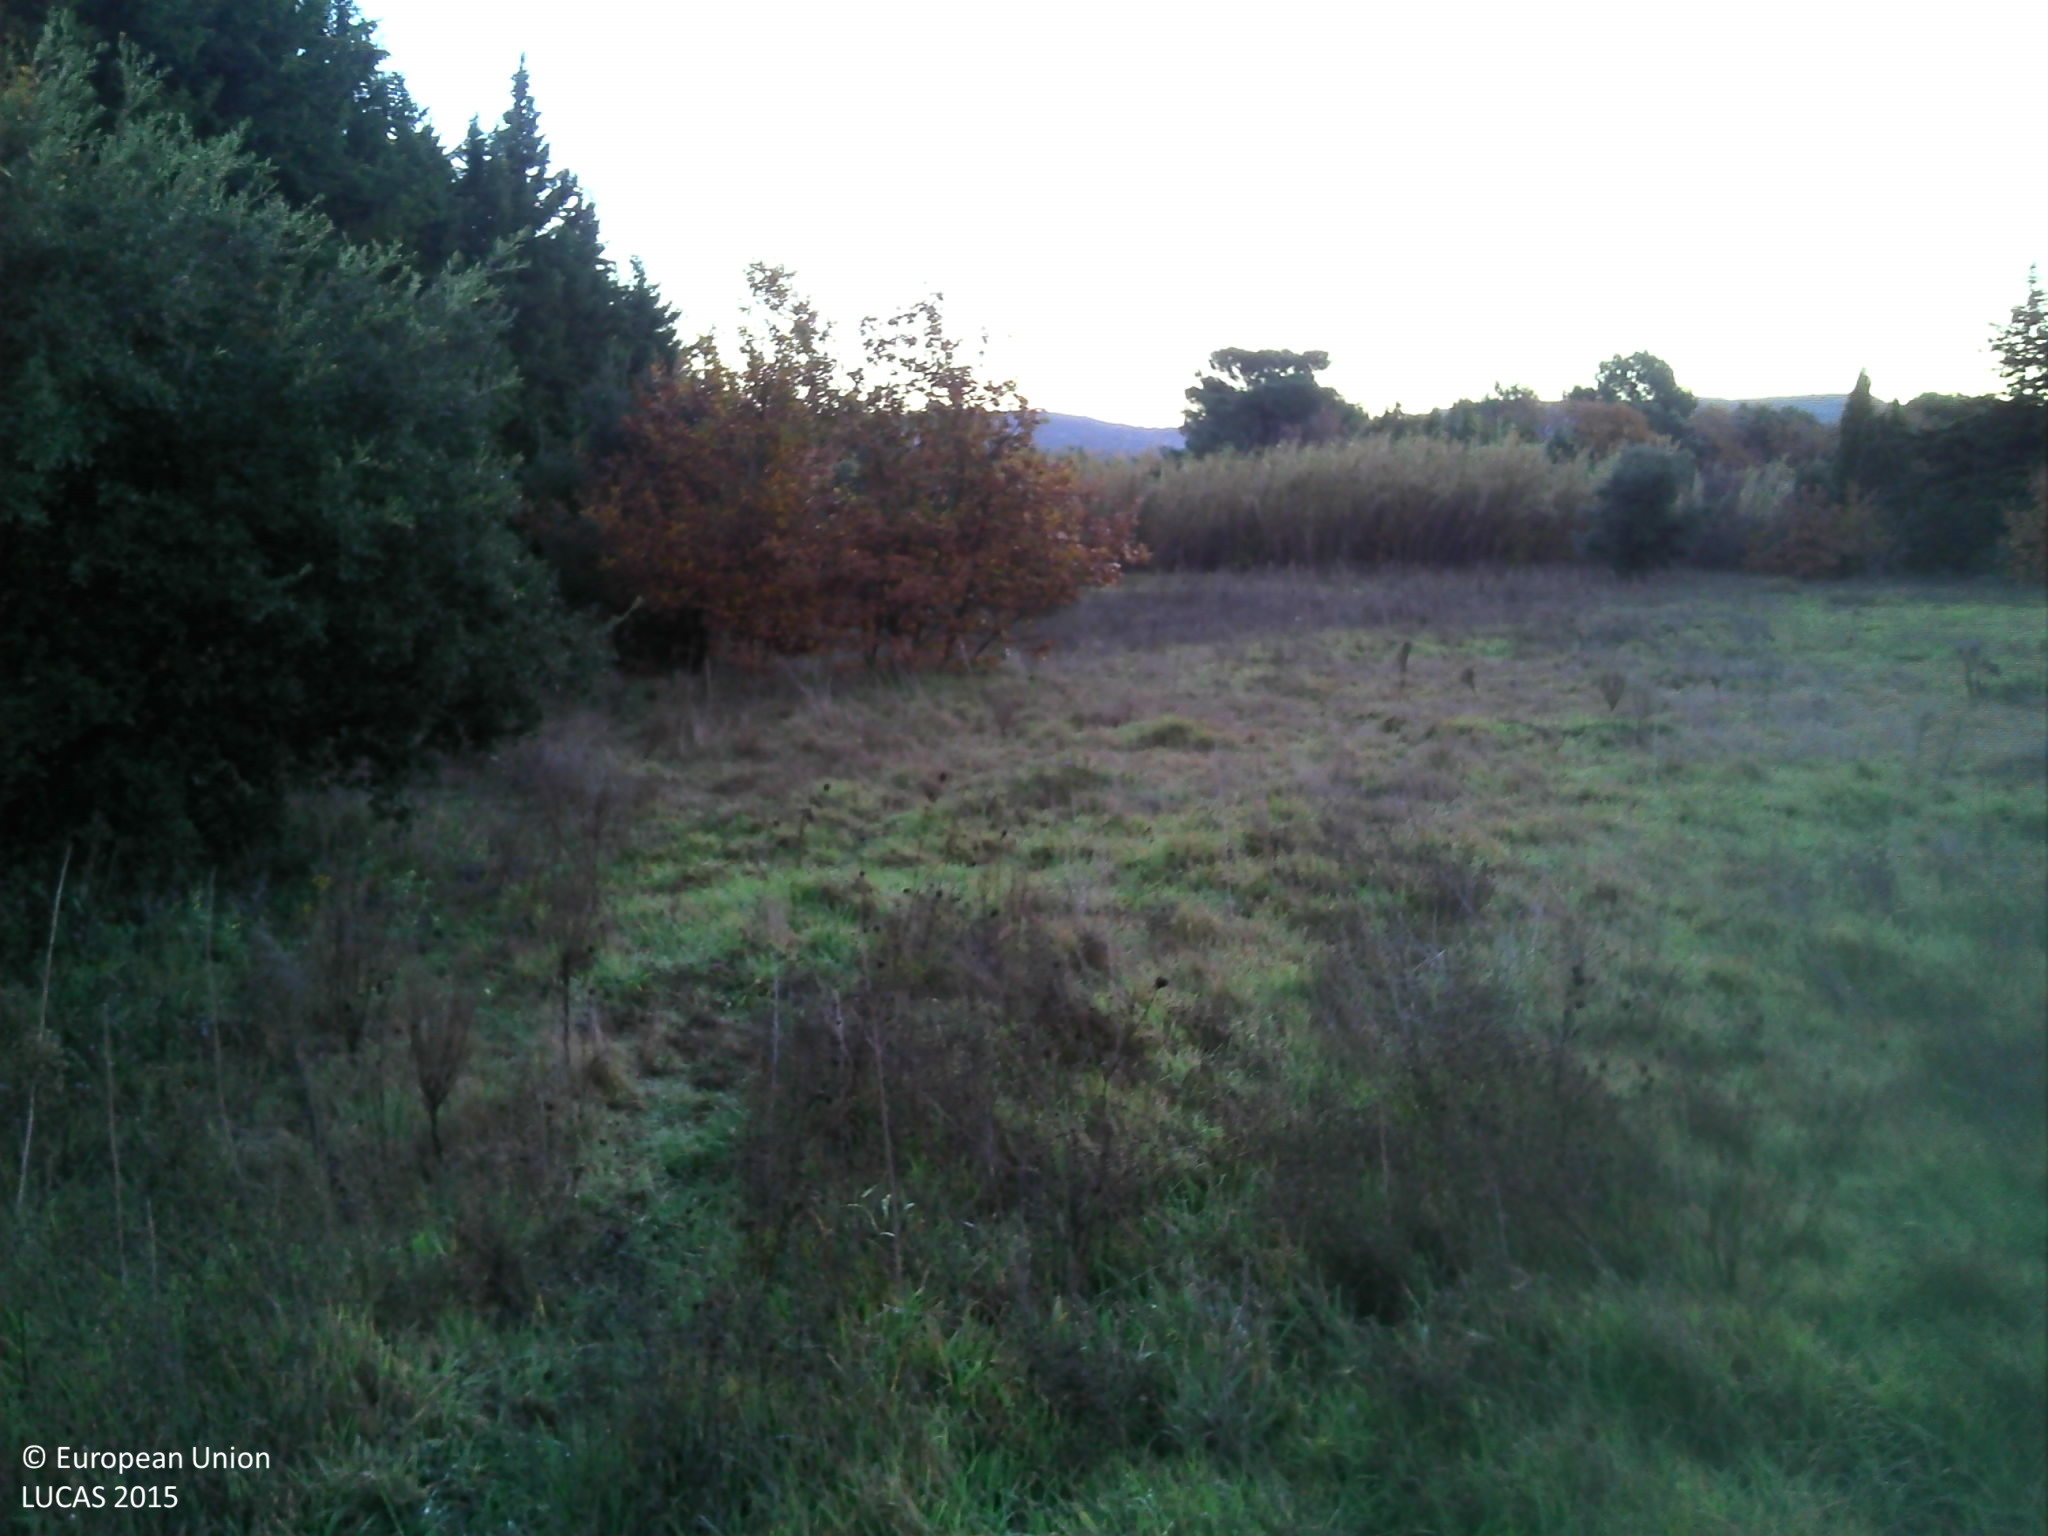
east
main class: Grassland
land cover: Grassland with sparse tree/shrub cover
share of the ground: > 75 %
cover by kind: herbaceous plants 85 %, shrubs 10 %, broadleaved forest trees 5 %
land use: Fallow land
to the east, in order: Grassland with sparse tree/shrub cover; Electric lines; Grassland with sparse tree/shrub cover; Spontaneously vegetated surfaces; Grassland with sparse tree/shrub cover; Broadleaved woodland; Other non-permanent industrial crops
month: December
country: FR
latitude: 44.3635
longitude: 4.7749
